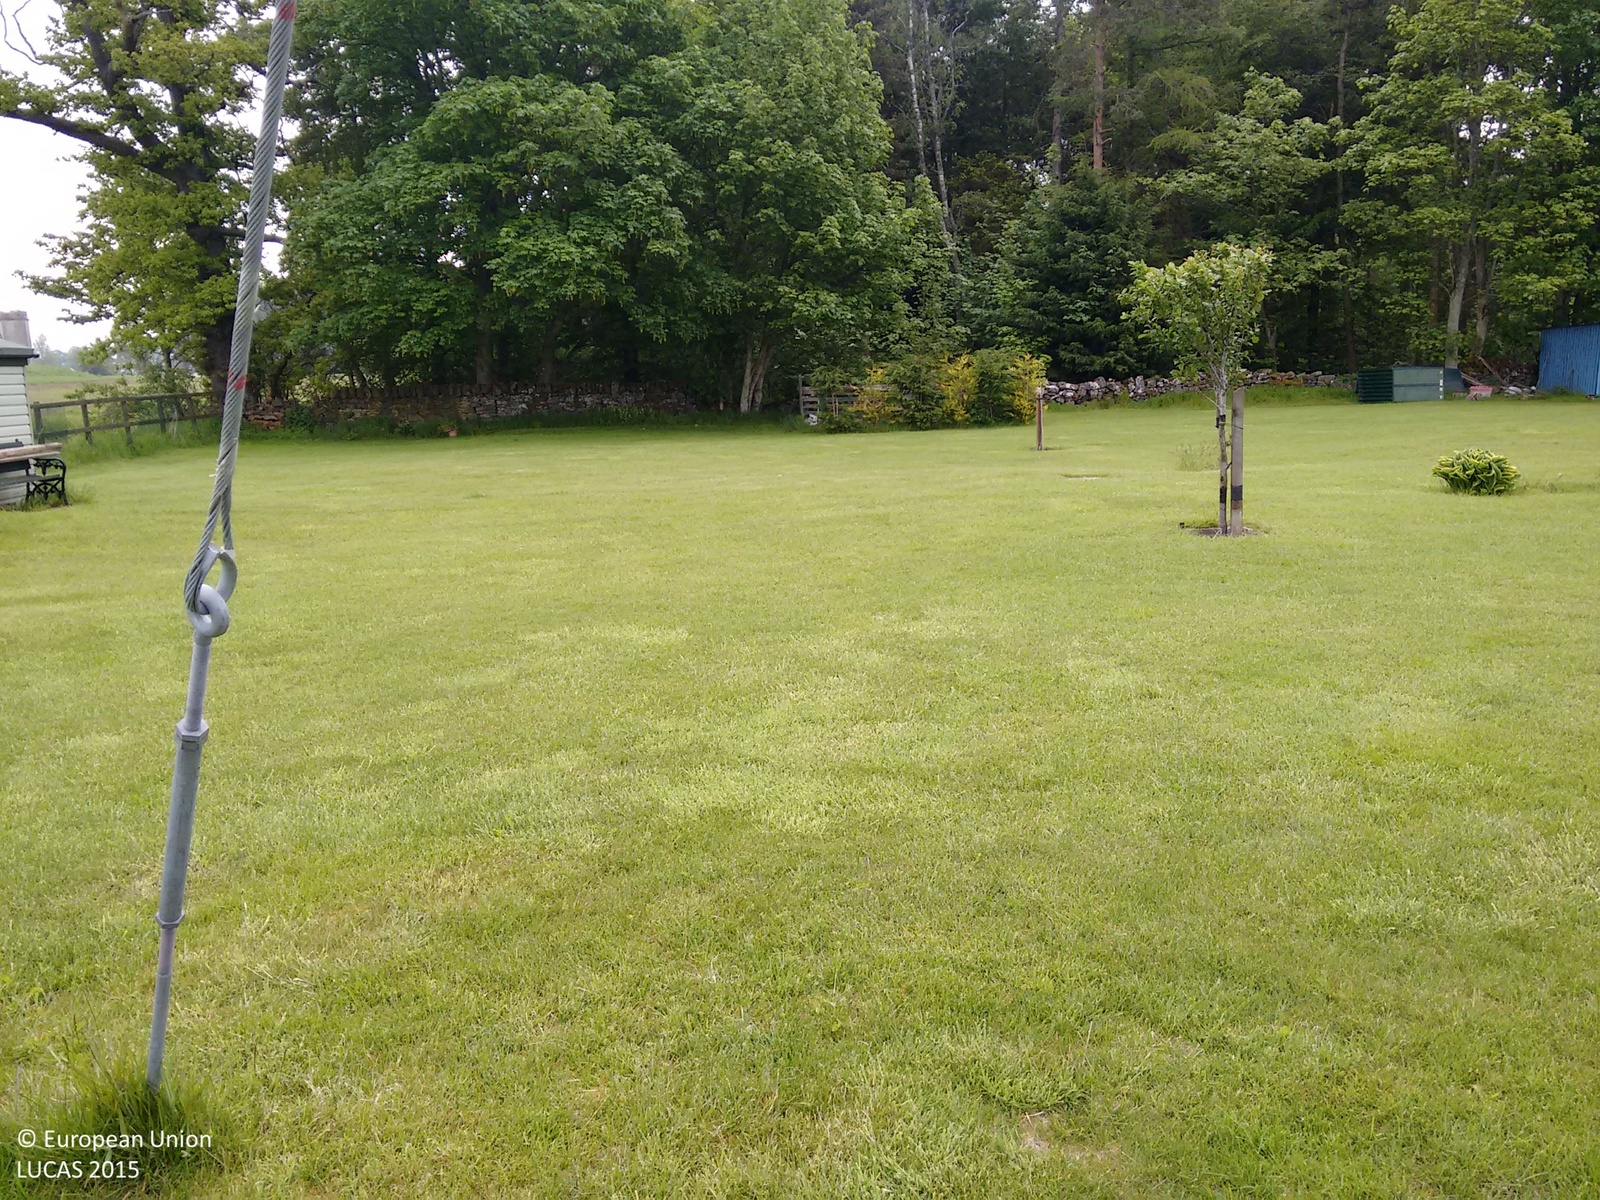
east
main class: Grassland
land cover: Grassland without tree/shrub cover
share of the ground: > 75 %
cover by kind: herbaceous plants 100 %
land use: Residential
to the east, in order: Grassland without tree/shrub cover; Artificial constructions in urban areas; Dry stone walls; Broadleaved woodland; Ditches and canals; Grassland without tree/shrub cover; Fences; Grassland with sparse tree/shrub cover; Fences; Broadleaved woodland
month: June
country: GB
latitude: 56.3476
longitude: -3.4891
